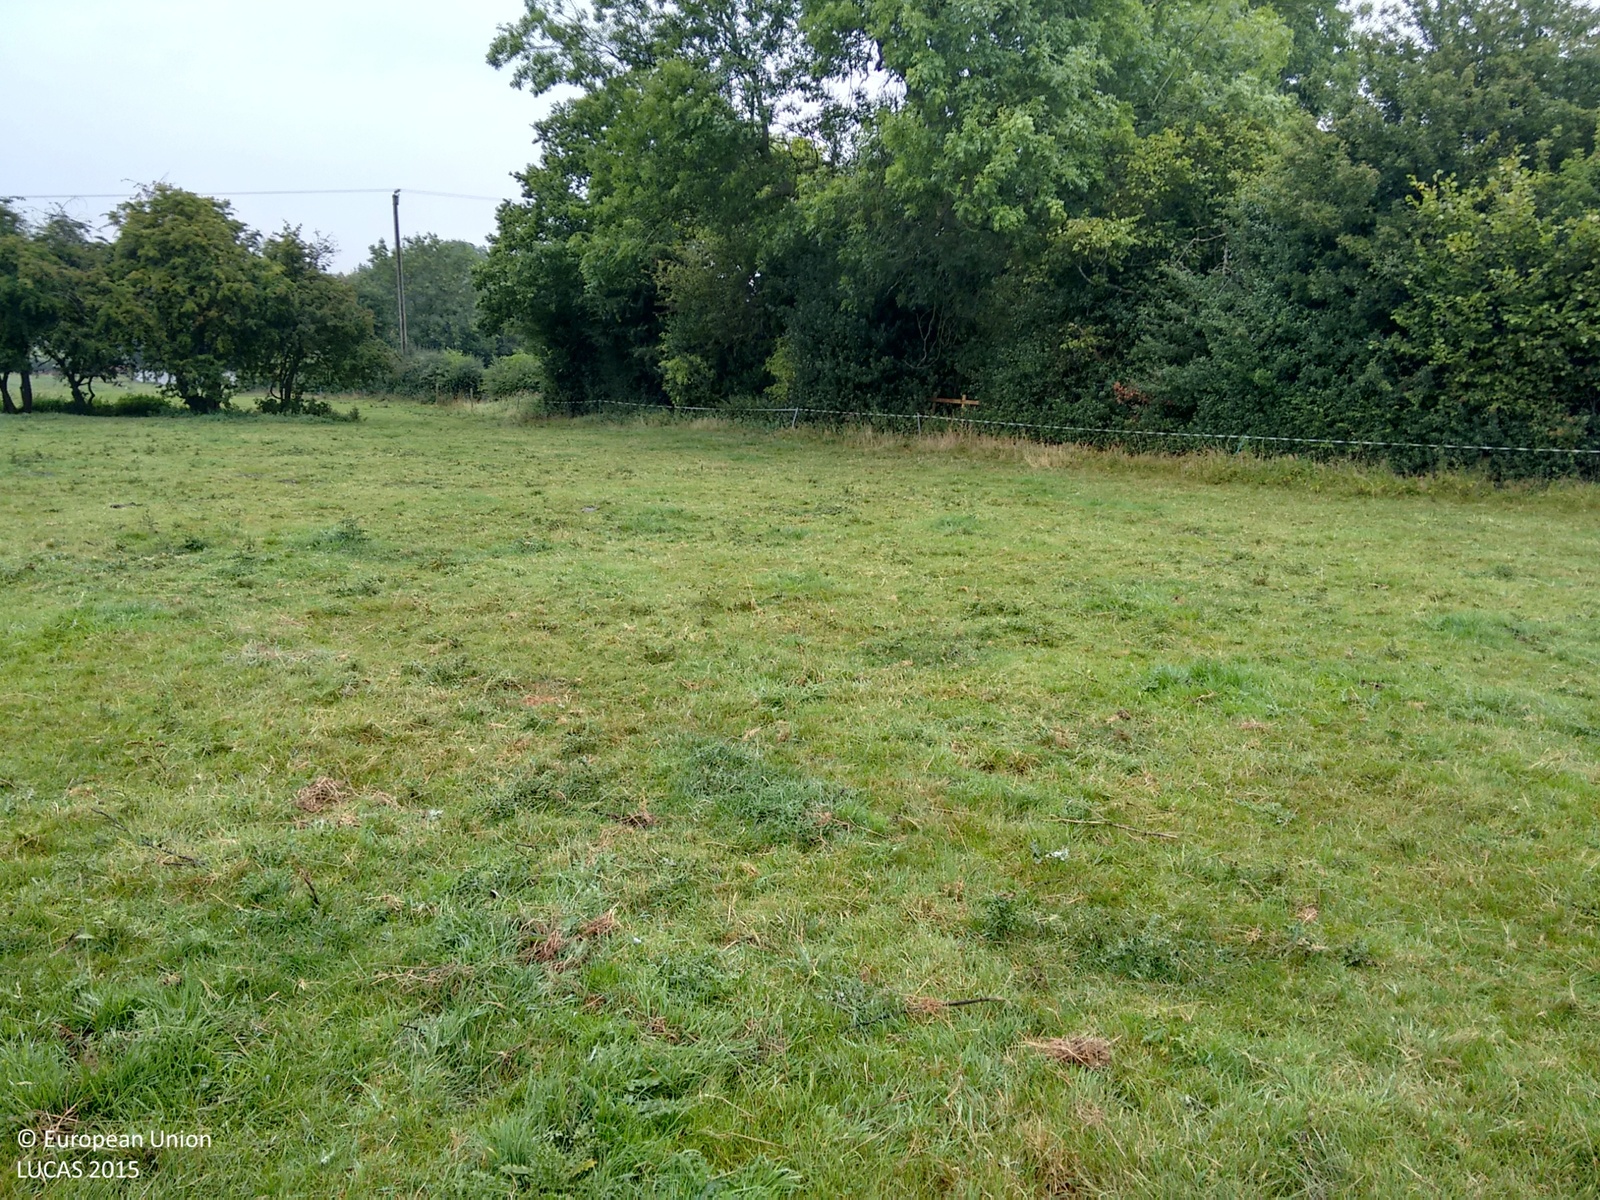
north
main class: Grassland
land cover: Grassland without tree/shrub cover
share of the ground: > 75 %
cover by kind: herbaceous plants 100 %
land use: Agriculture (excluding fallow land and kitchen gardens)
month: August
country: GB
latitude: 52.6273
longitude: -1.3805
